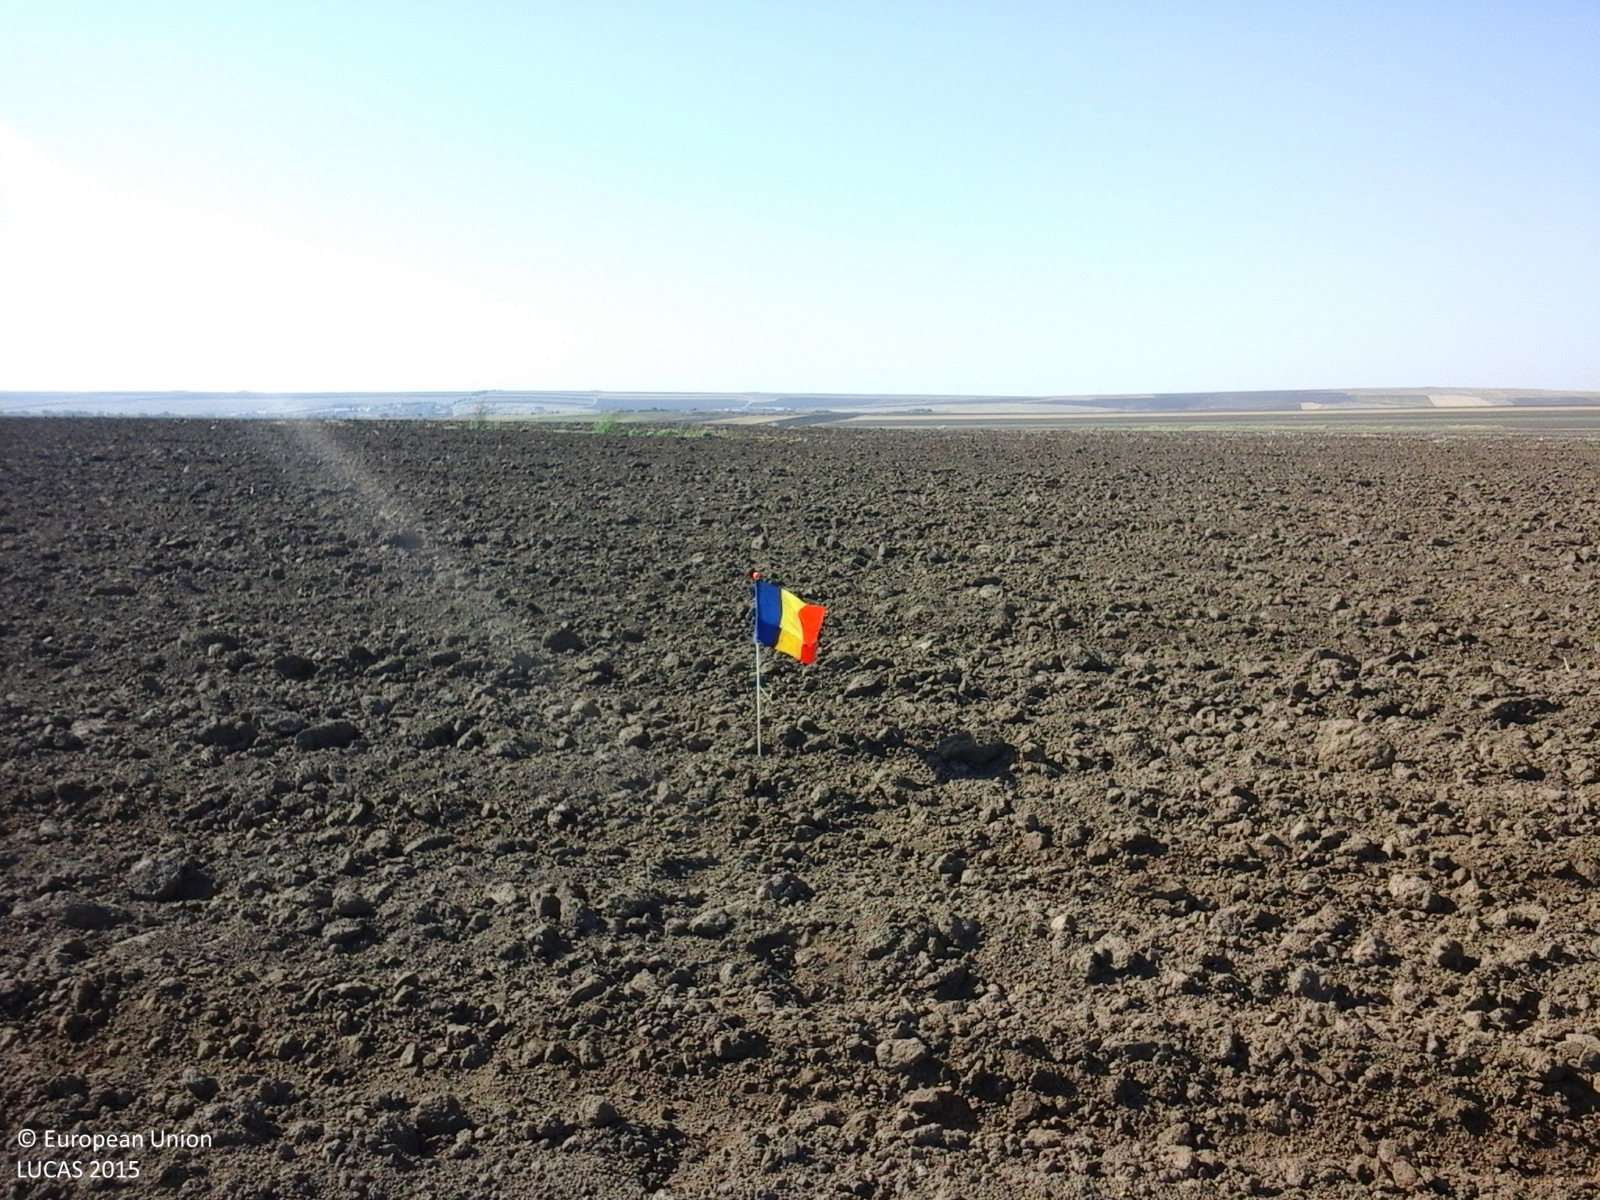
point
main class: Cropland
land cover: Common wheat
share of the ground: < 10 %
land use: Agriculture (excluding fallow land and kitchen gardens)
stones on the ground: < 10 %
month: August
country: RO
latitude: 44.5104
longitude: 28.6319
